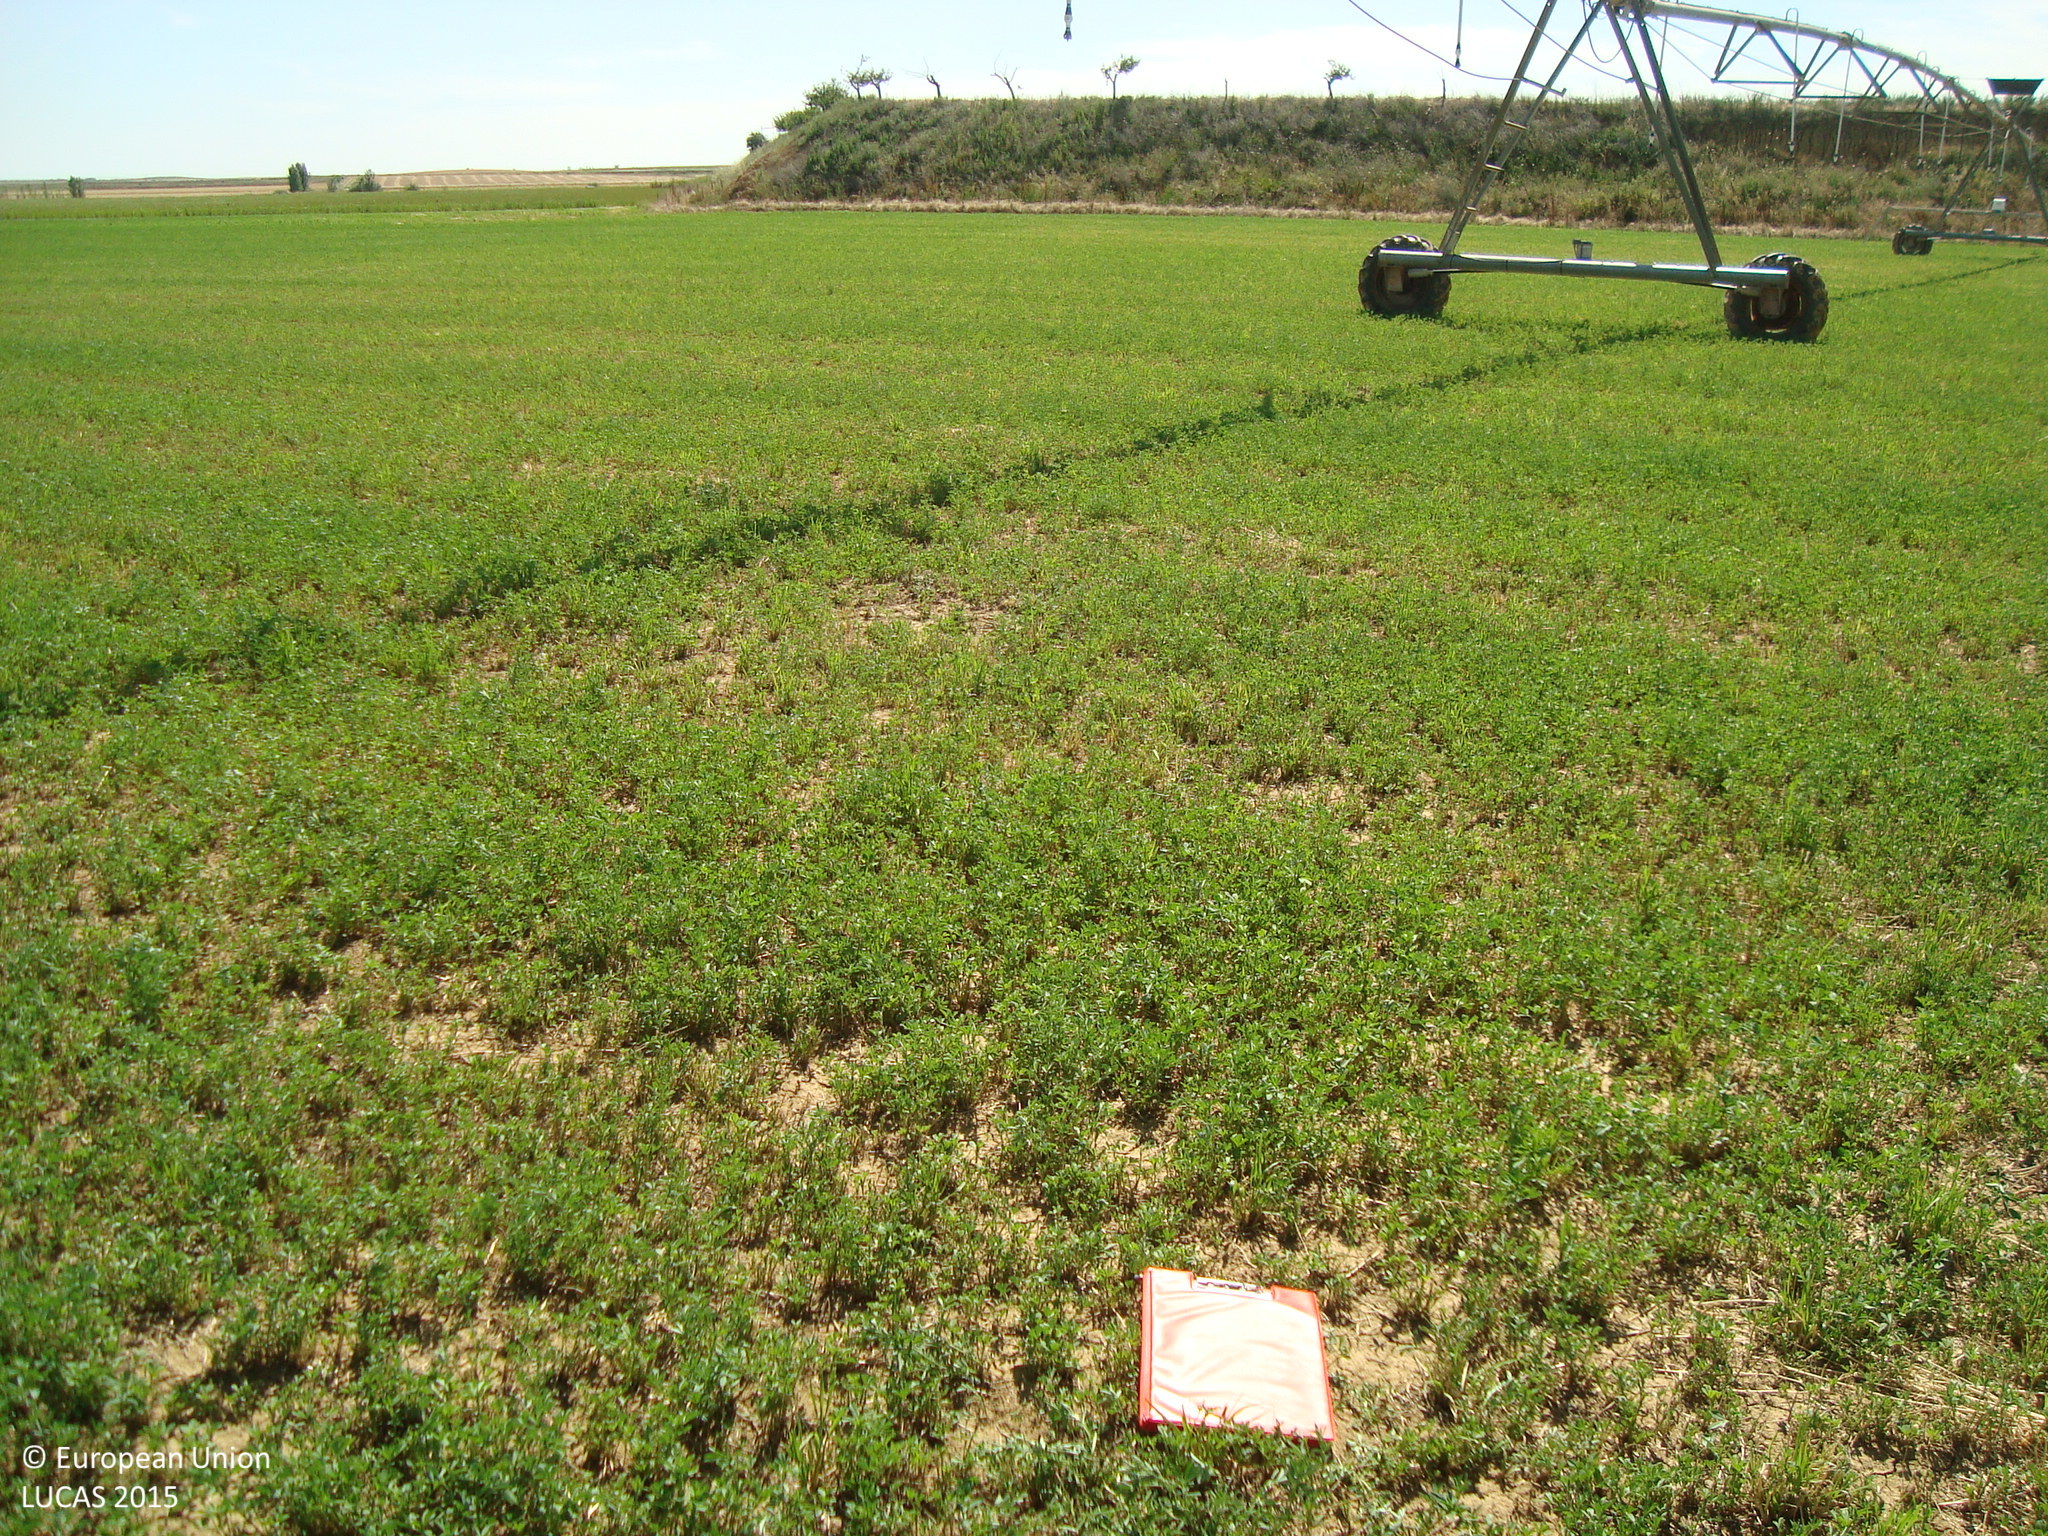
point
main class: Cropland
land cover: Lucerne
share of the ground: > 75 %
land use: Agriculture (excluding fallow land and kitchen gardens)
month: July
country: ES
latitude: 42.1354
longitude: -4.7510
